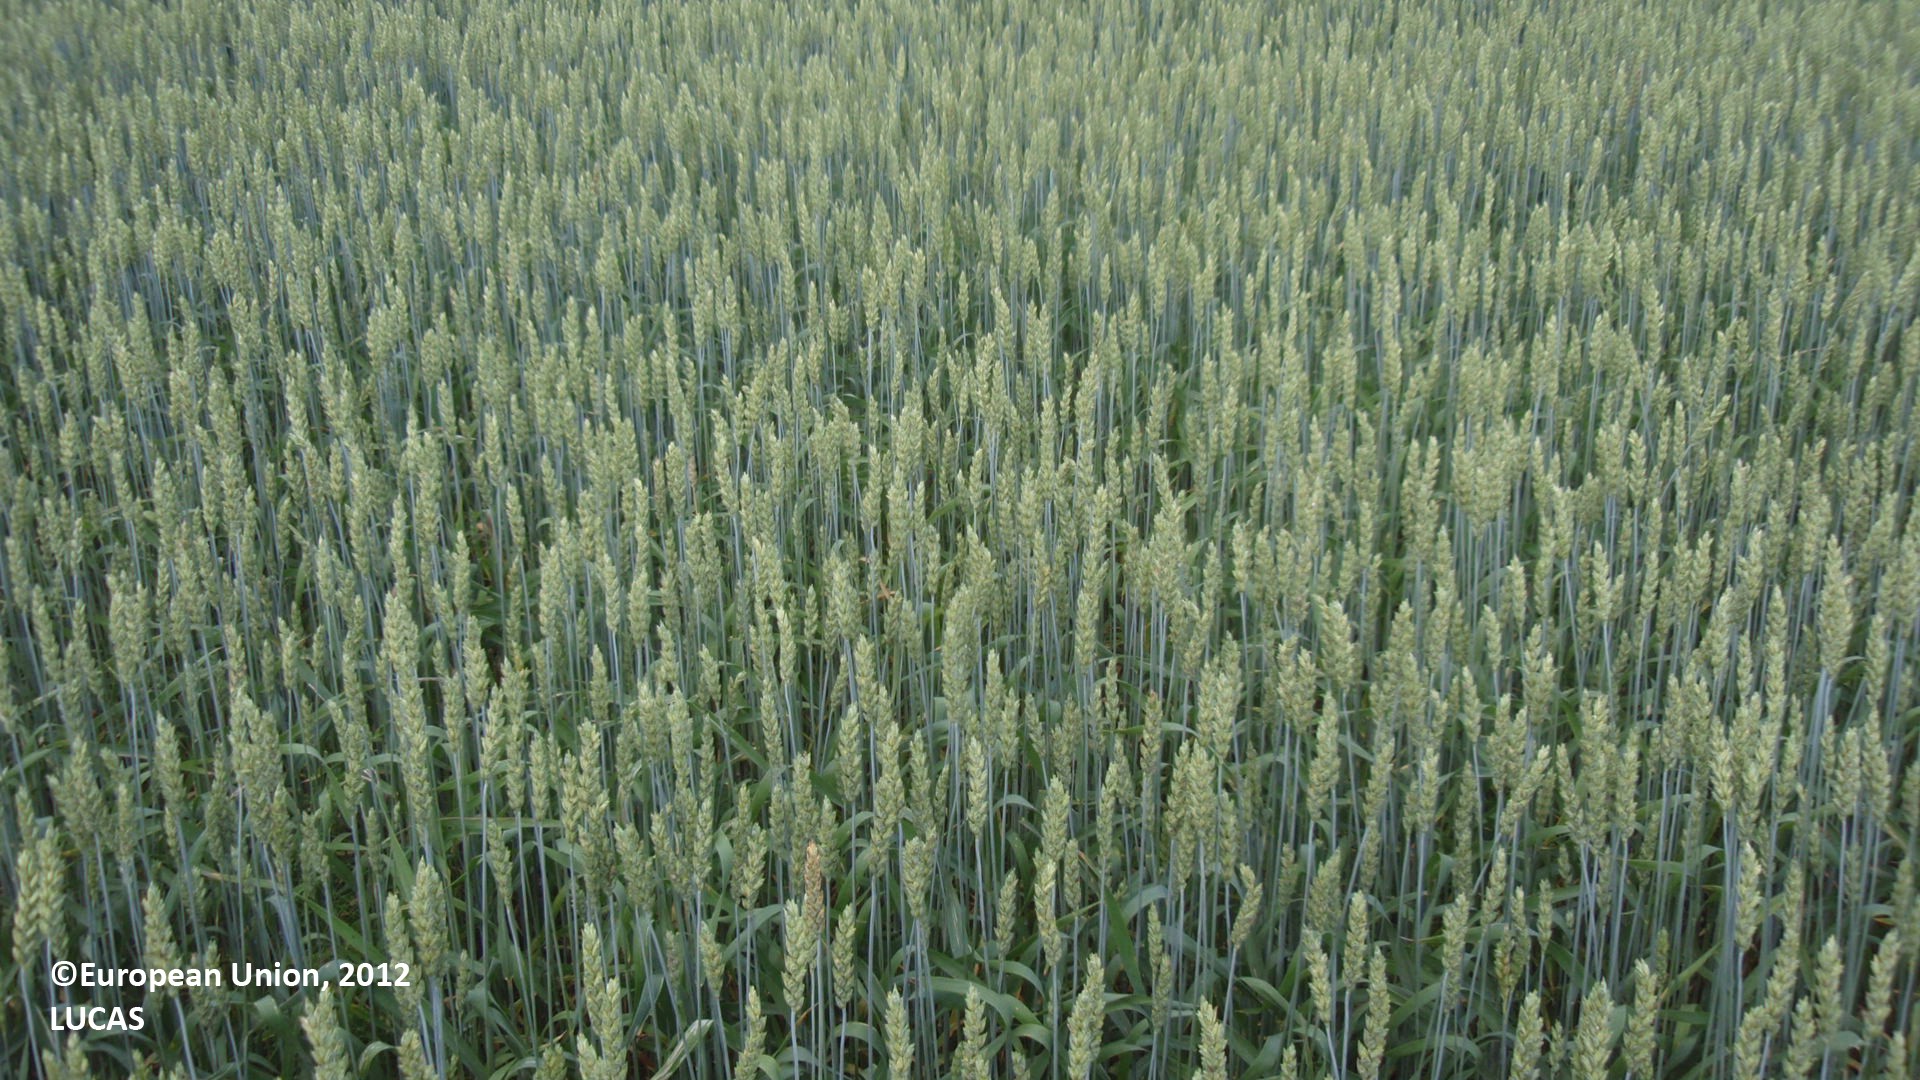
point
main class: Cropland
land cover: Oats
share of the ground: > 75 %
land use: Agriculture (excluding fallow land and kitchen gardens)
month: July
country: FI
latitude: 60.9667
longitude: 28.4848
